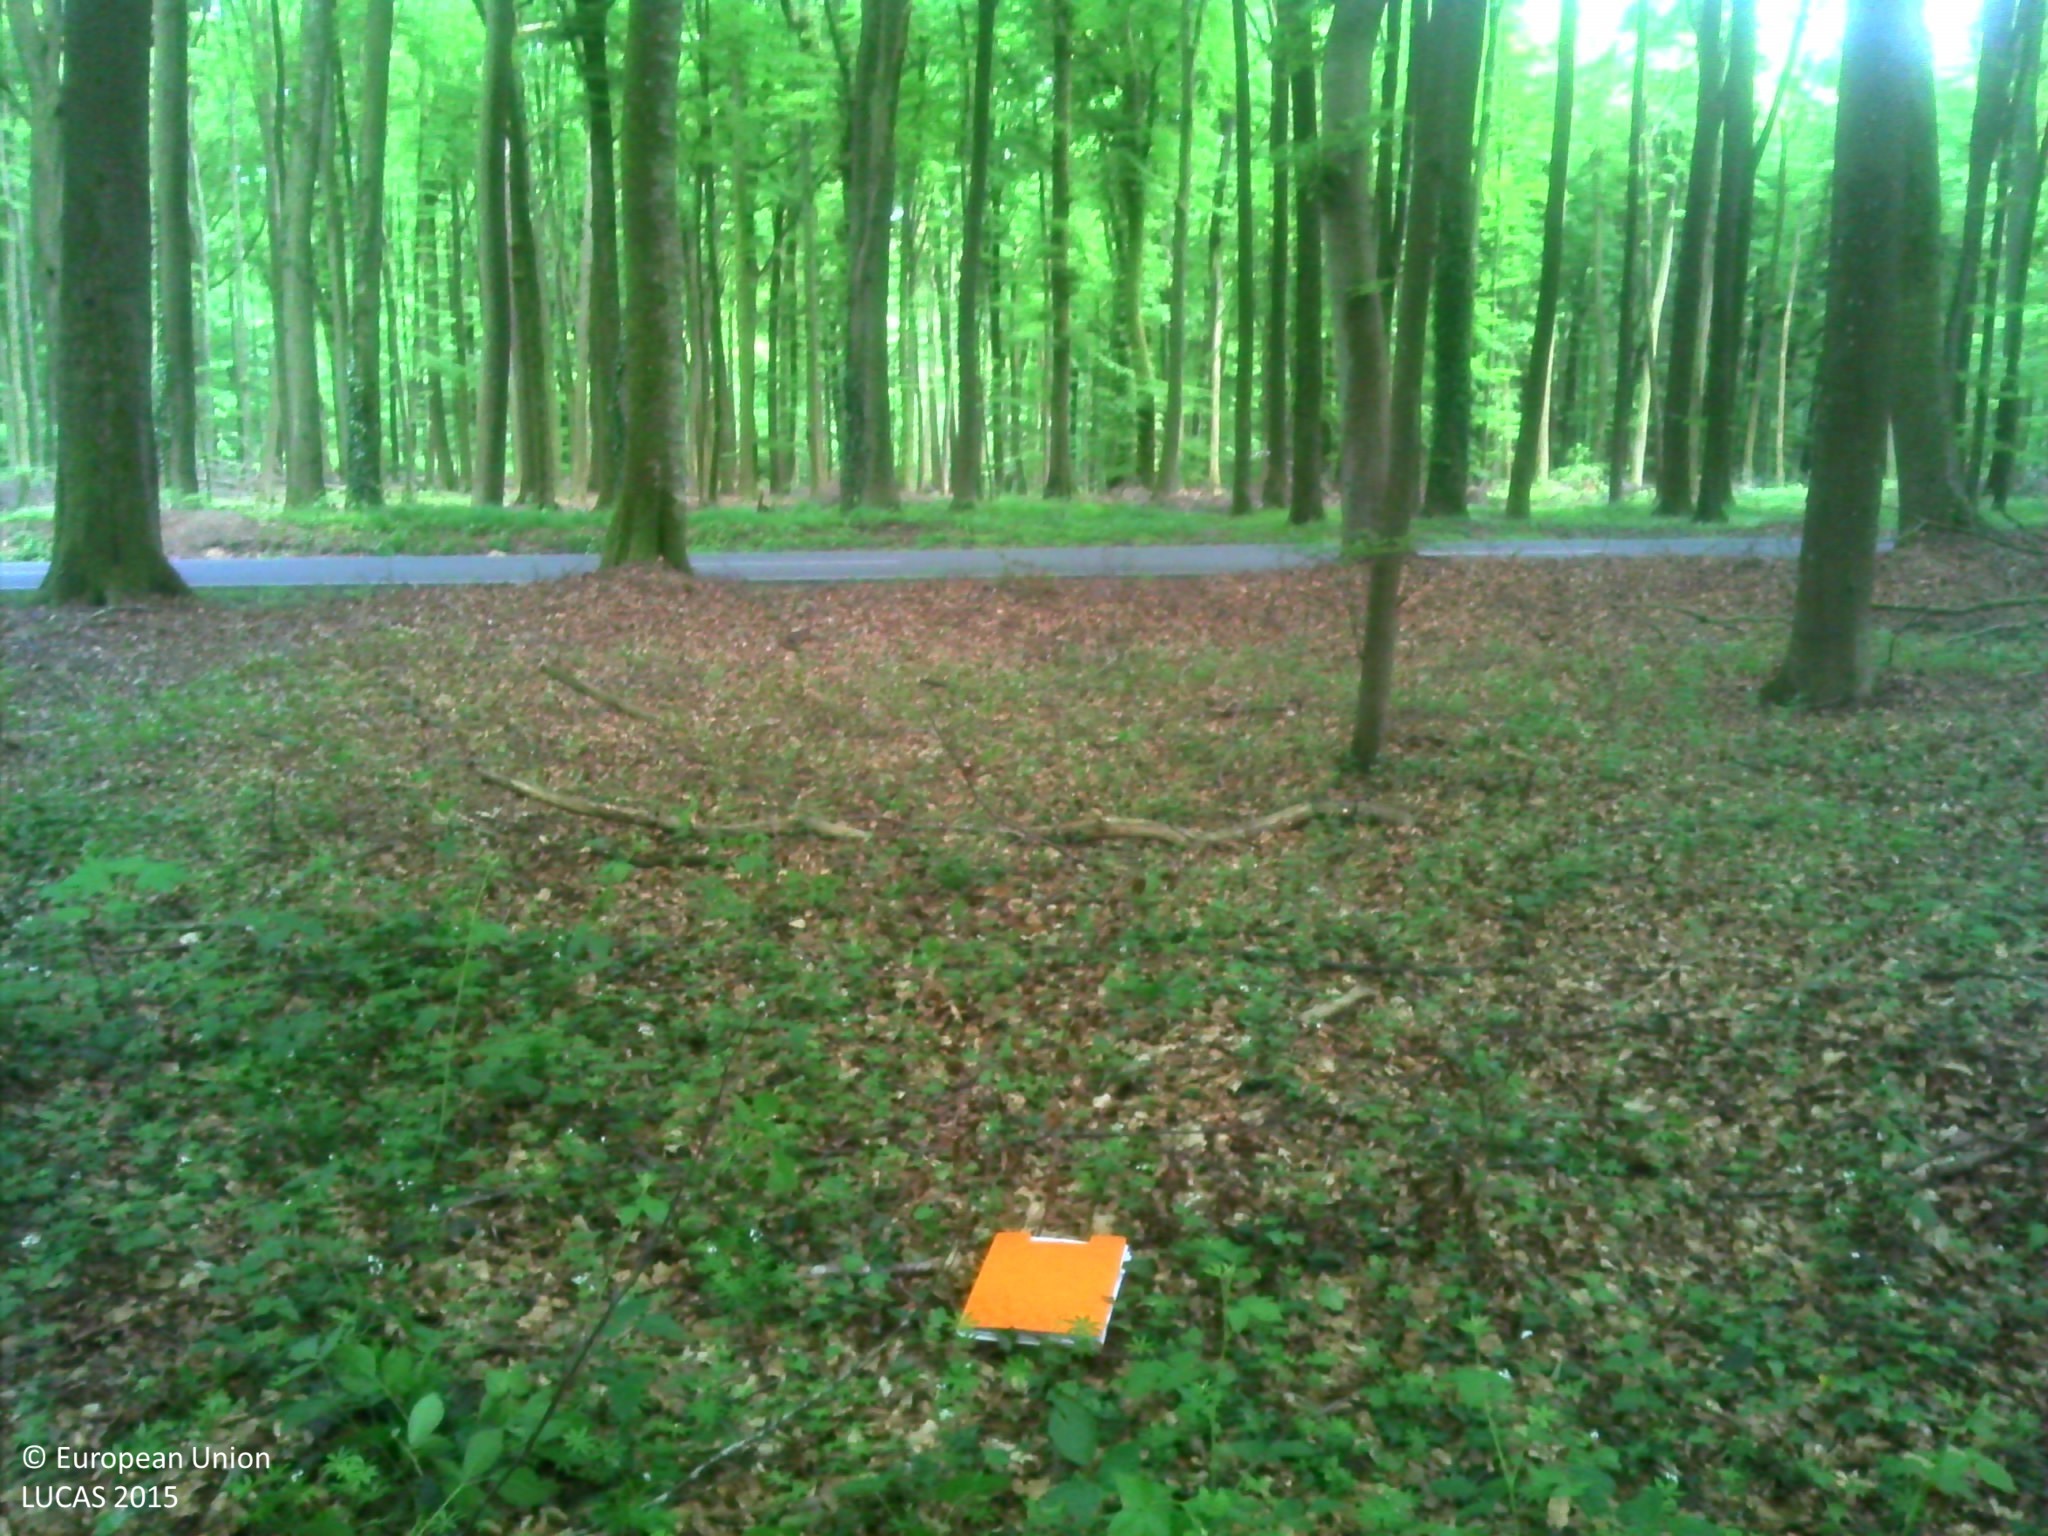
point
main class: Woodland
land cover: Broadleaved woodland
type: beech forest
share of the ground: > 75 %
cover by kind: broadleaved forest trees 90 %, herbaceous plants 10 %
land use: Forestry
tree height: > 5 m
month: May
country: LU
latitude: 49.7167
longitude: 5.9631
